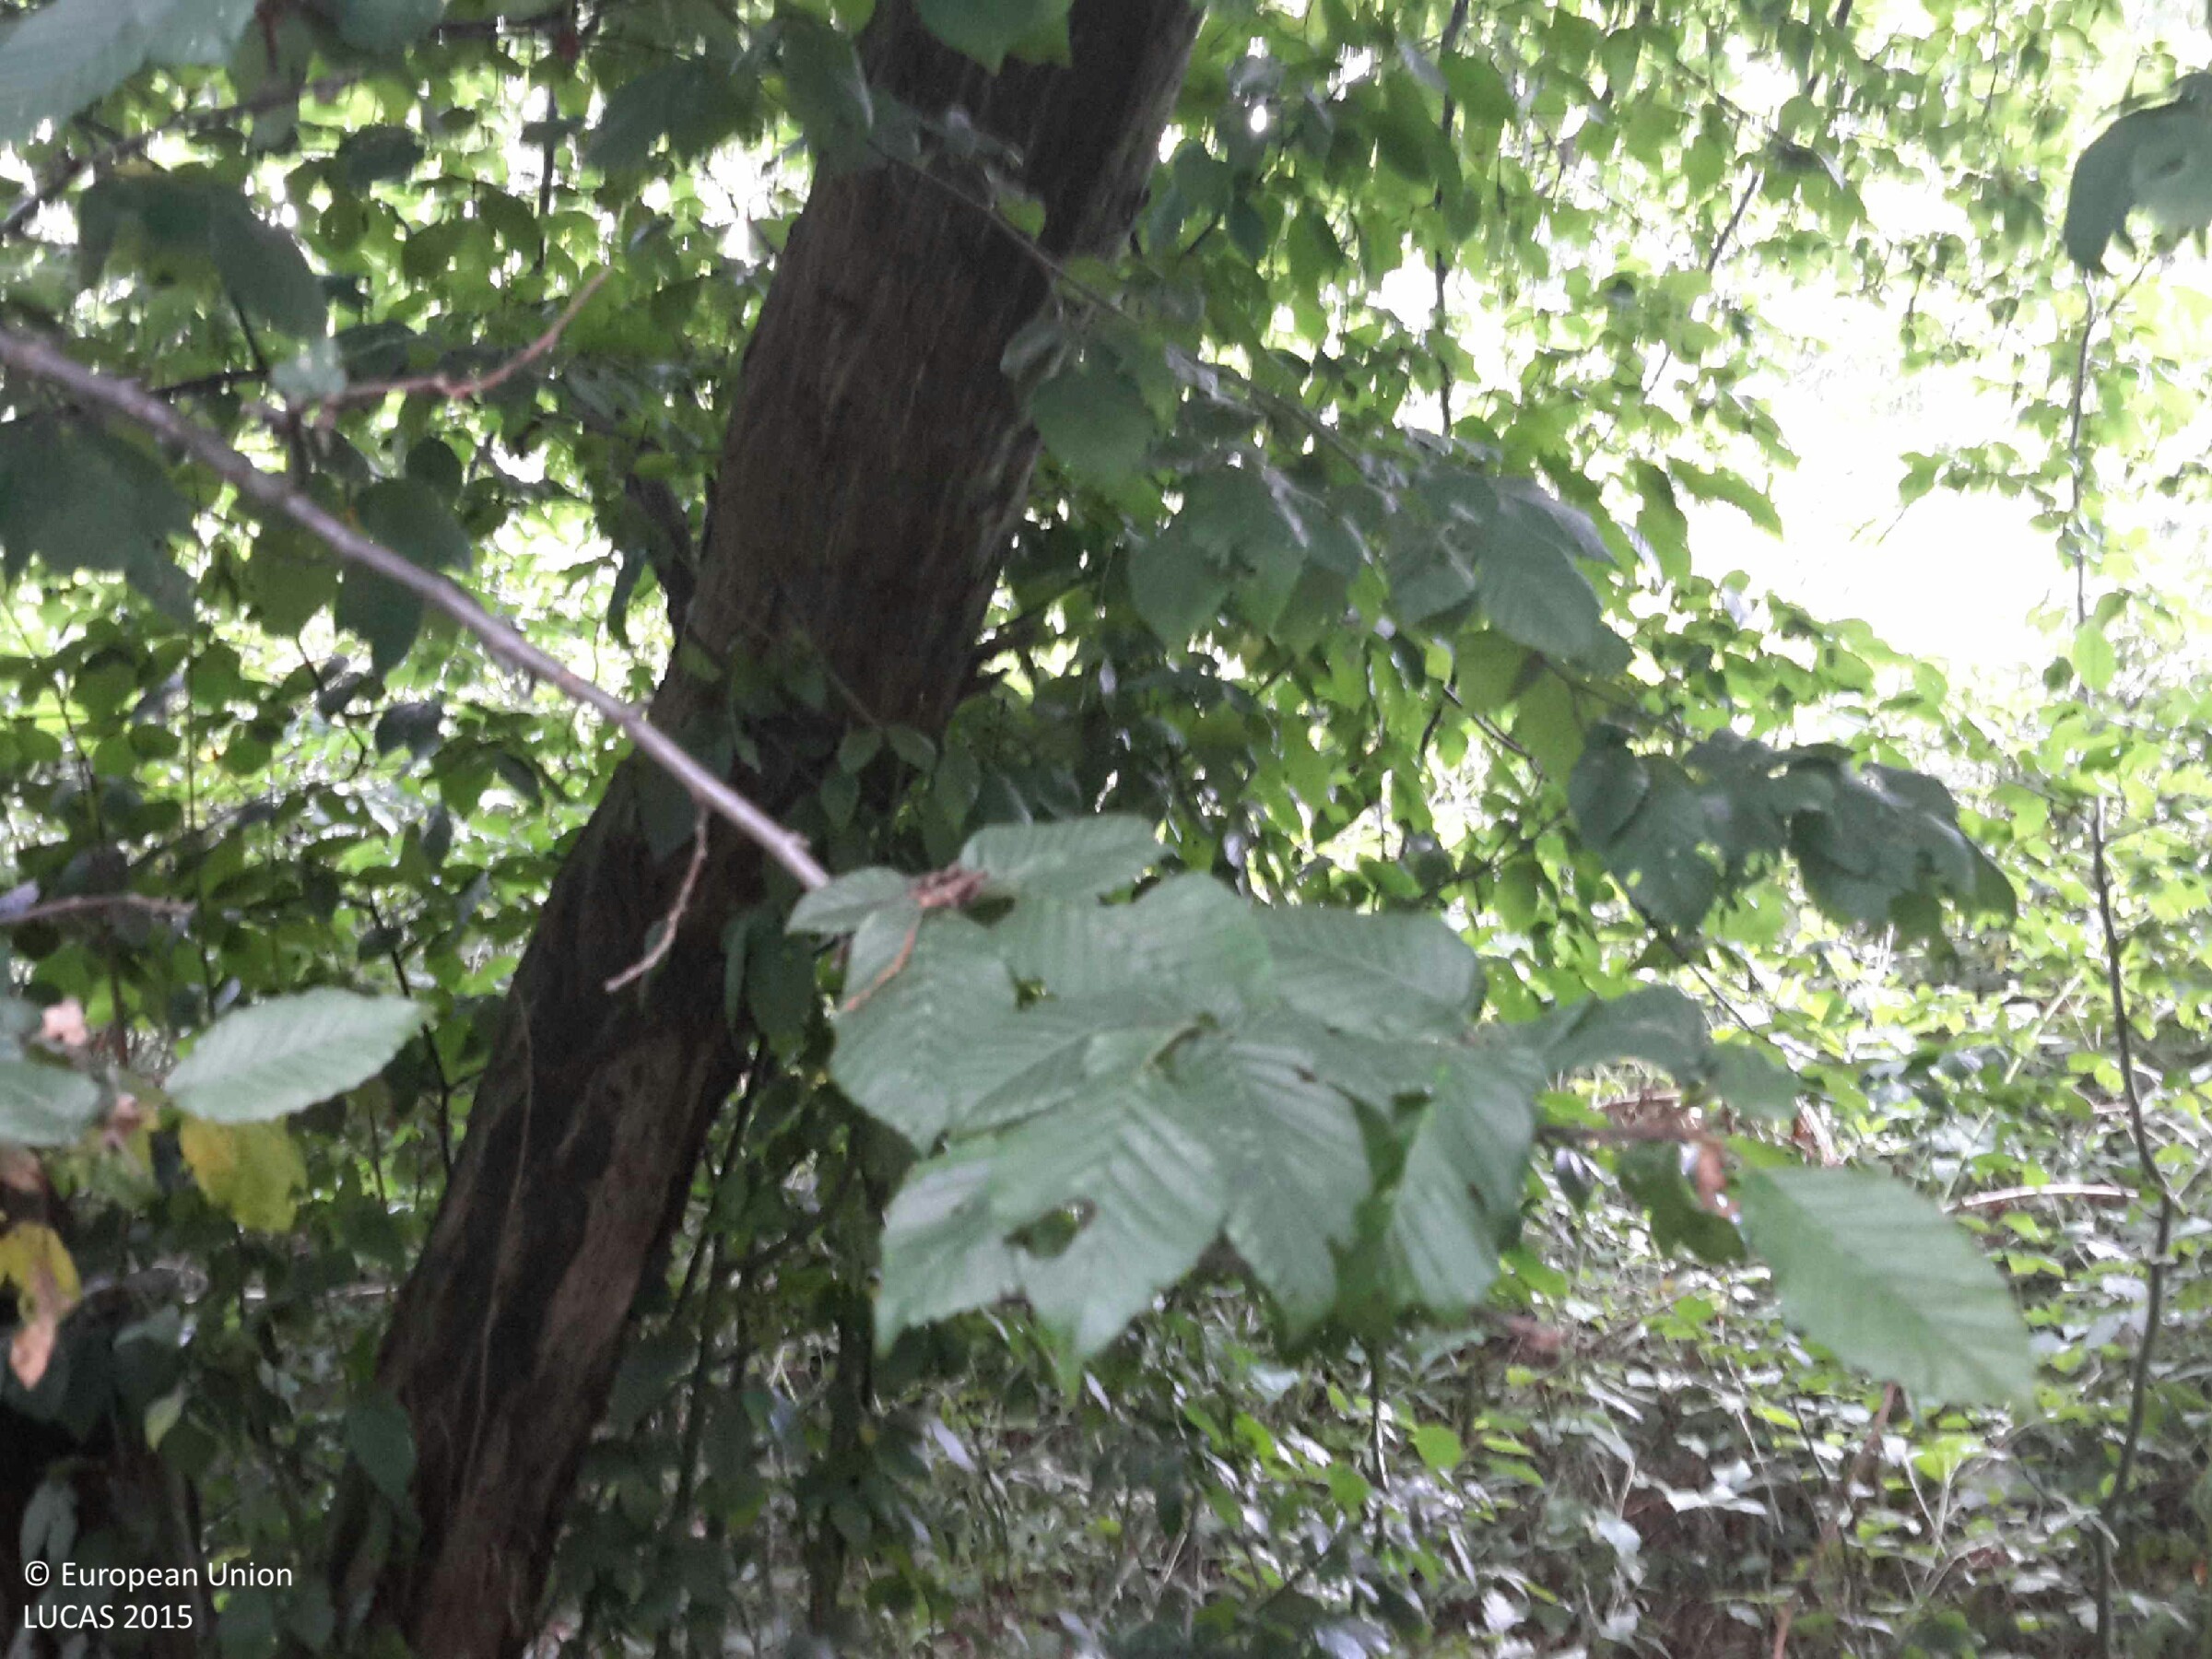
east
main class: Woodland
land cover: Broadleaved woodland
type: mesophytic deciduous forest
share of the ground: > 75 %
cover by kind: broadleaved forest trees 80 %, herbaceous plants 20 %
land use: Forestry
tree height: > 5 m
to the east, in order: Broadleaved woodland; Tracks; Broadleaved woodland
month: July
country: HU
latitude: 47.4241
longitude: 17.2578
